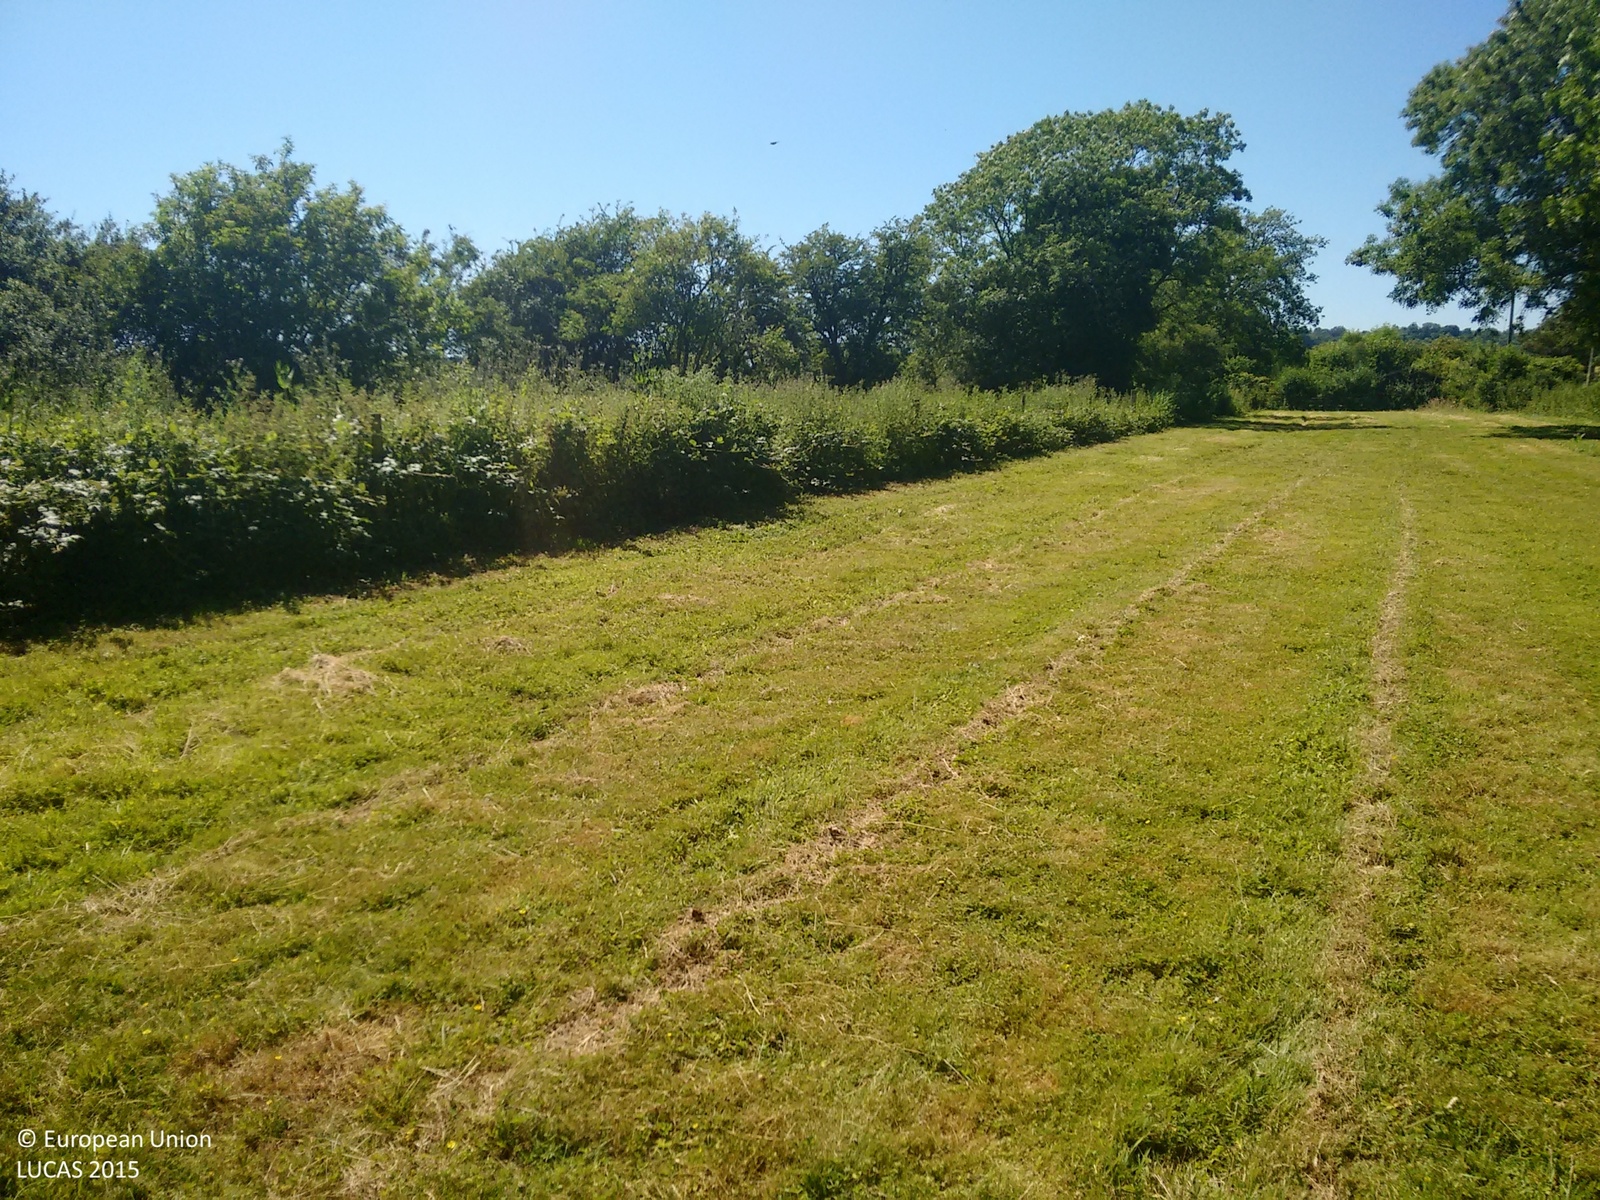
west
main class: Grassland
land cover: Grassland without tree/shrub cover
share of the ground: > 75 %
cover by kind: herbaceous plants 100 %
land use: Agriculture (excluding fallow land and kitchen gardens)
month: June
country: GB
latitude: 50.8554
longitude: -0.5365
